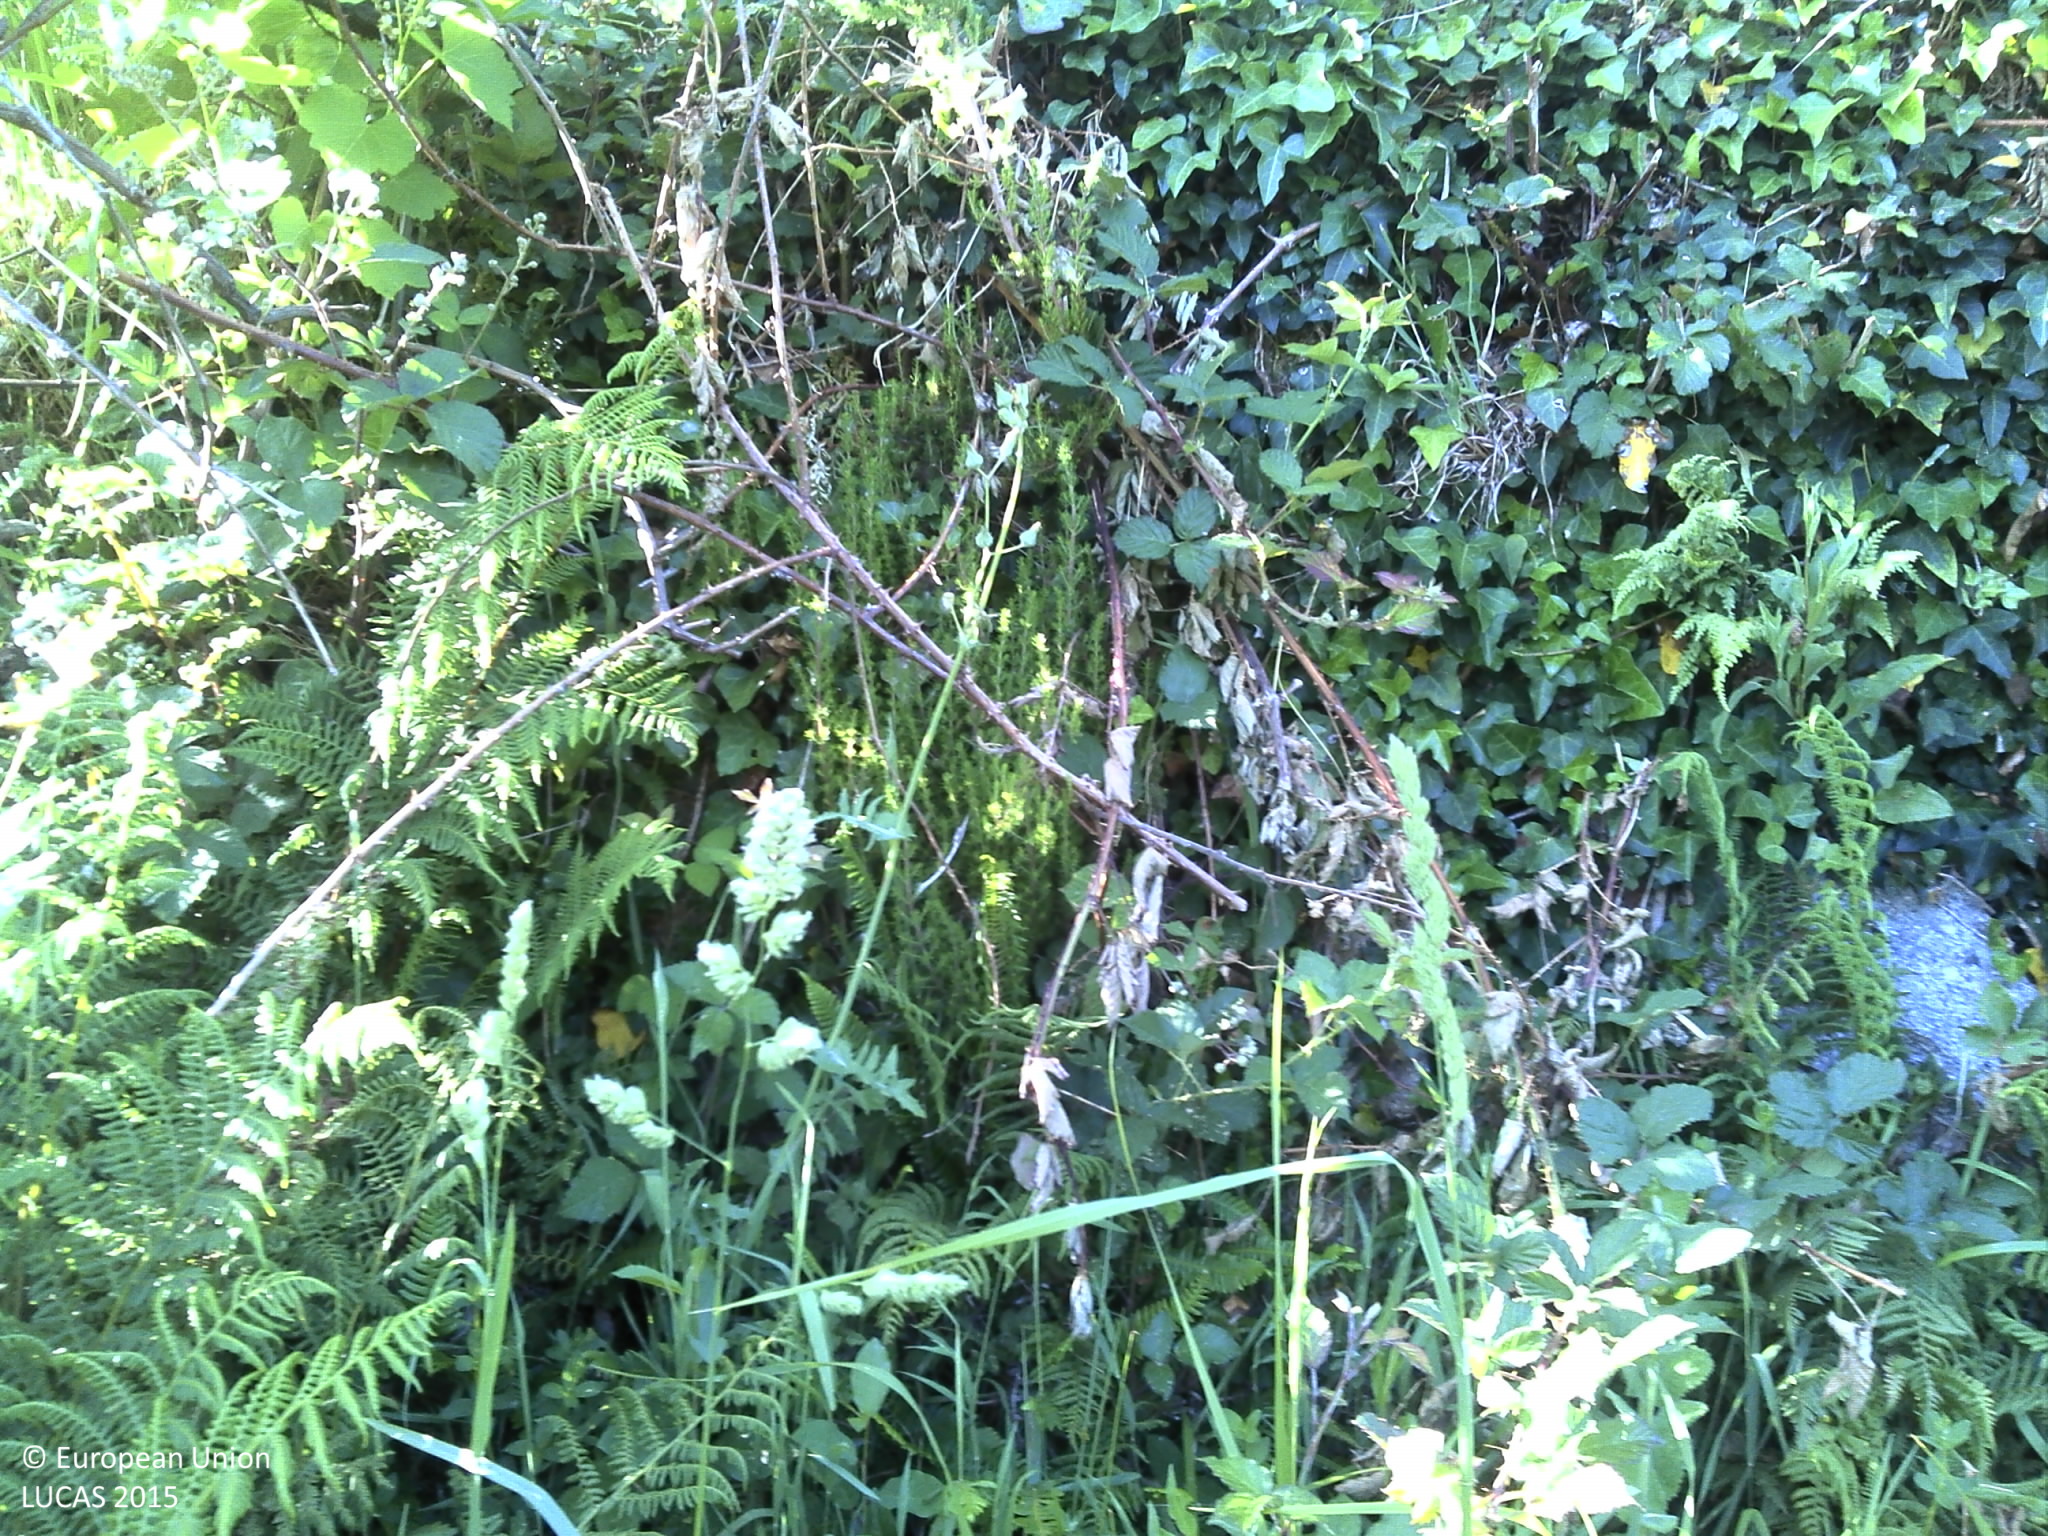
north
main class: Grassland
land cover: Grassland without tree/shrub cover
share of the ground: > 75 %
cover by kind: herbaceous plants 90 %, shrubs 5 %, unconsolidated bare surface 5 %
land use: Agriculture (excluding fallow land and kitchen gardens)
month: June
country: PT
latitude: 41.9510
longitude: -8.1883
